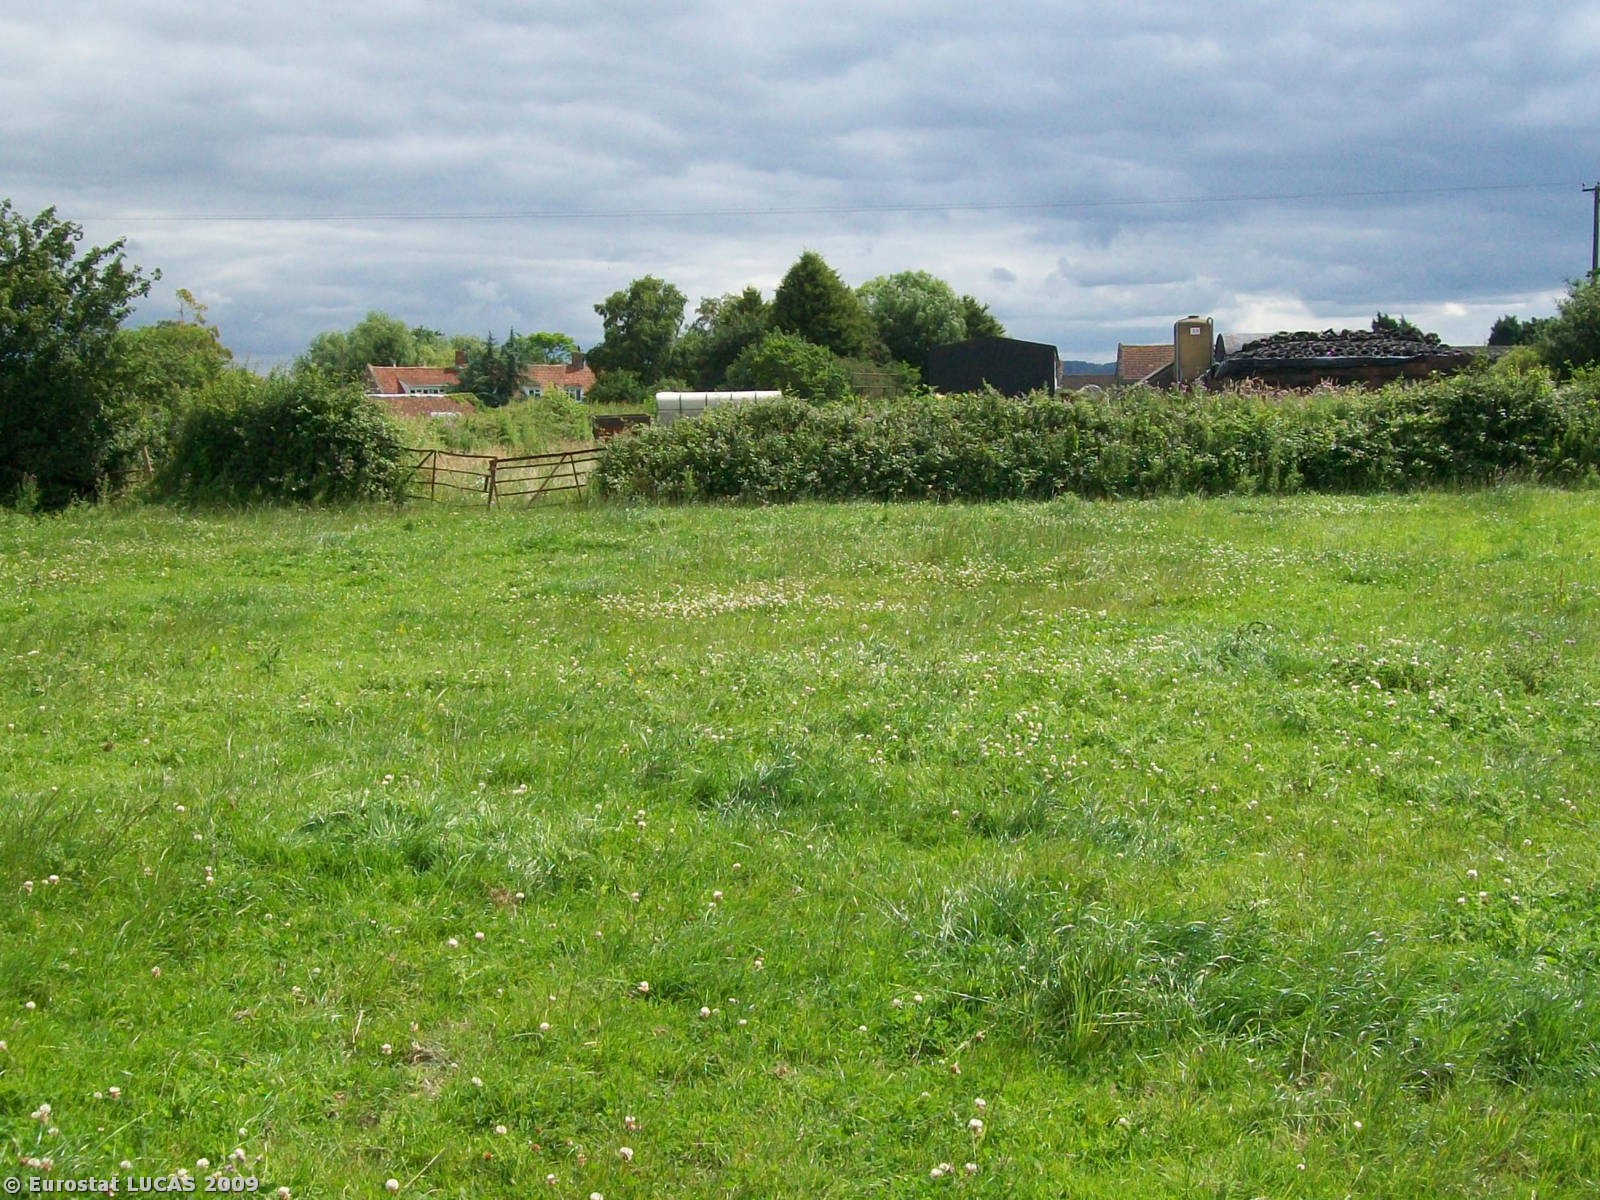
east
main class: Grassland
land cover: Grassland without tree/shrub cover
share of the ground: > 75 %
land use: Agriculture (excluding fallow land and kitchen gardens)
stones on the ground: 10 - 25 %
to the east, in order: Grassland without tree/shrub cover; Abandoned hedges; Grassland without tree/shrub cover; Artificial constructions; Artificial constructions in urban areas
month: July
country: GB
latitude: 51.1818
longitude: -2.7018
